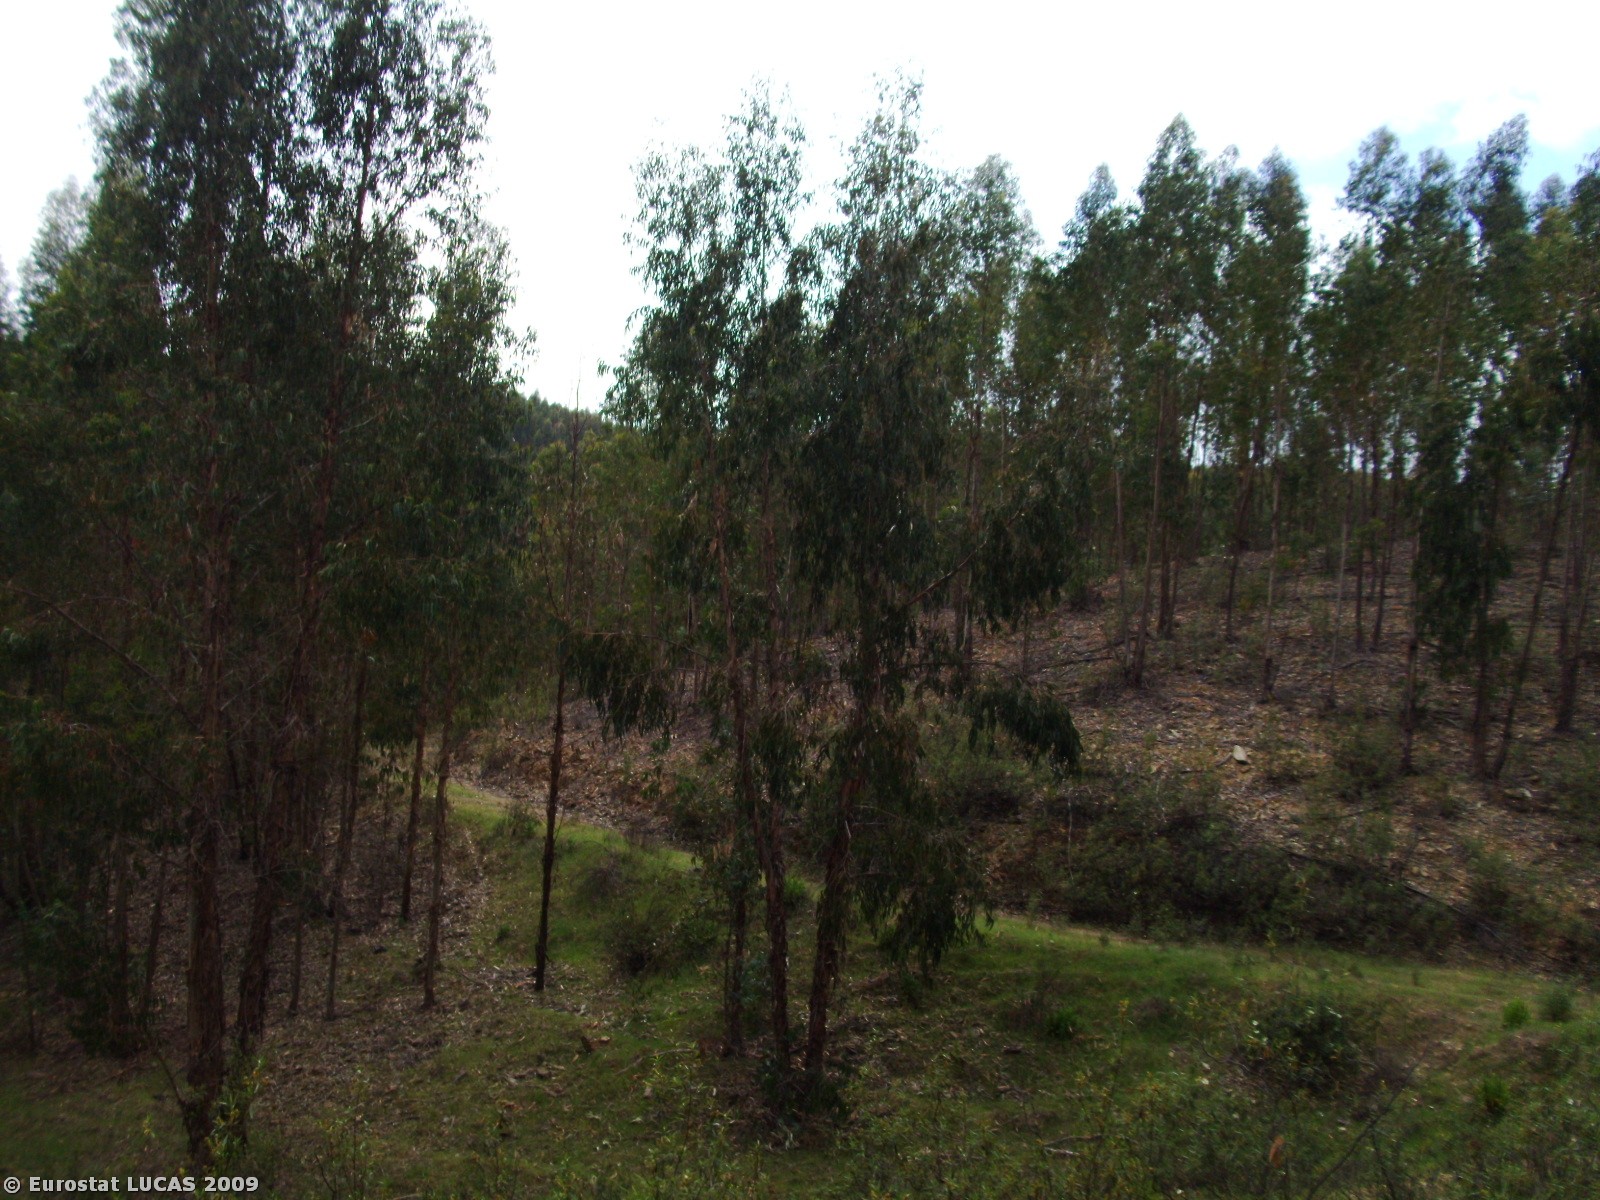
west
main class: Woodland
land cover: Broadleaved woodland
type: plantations and self-sown exotic forest
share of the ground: > 75 %
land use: Forestry
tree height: > 5 m
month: April
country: PT
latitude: 39.7648
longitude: -7.5271
